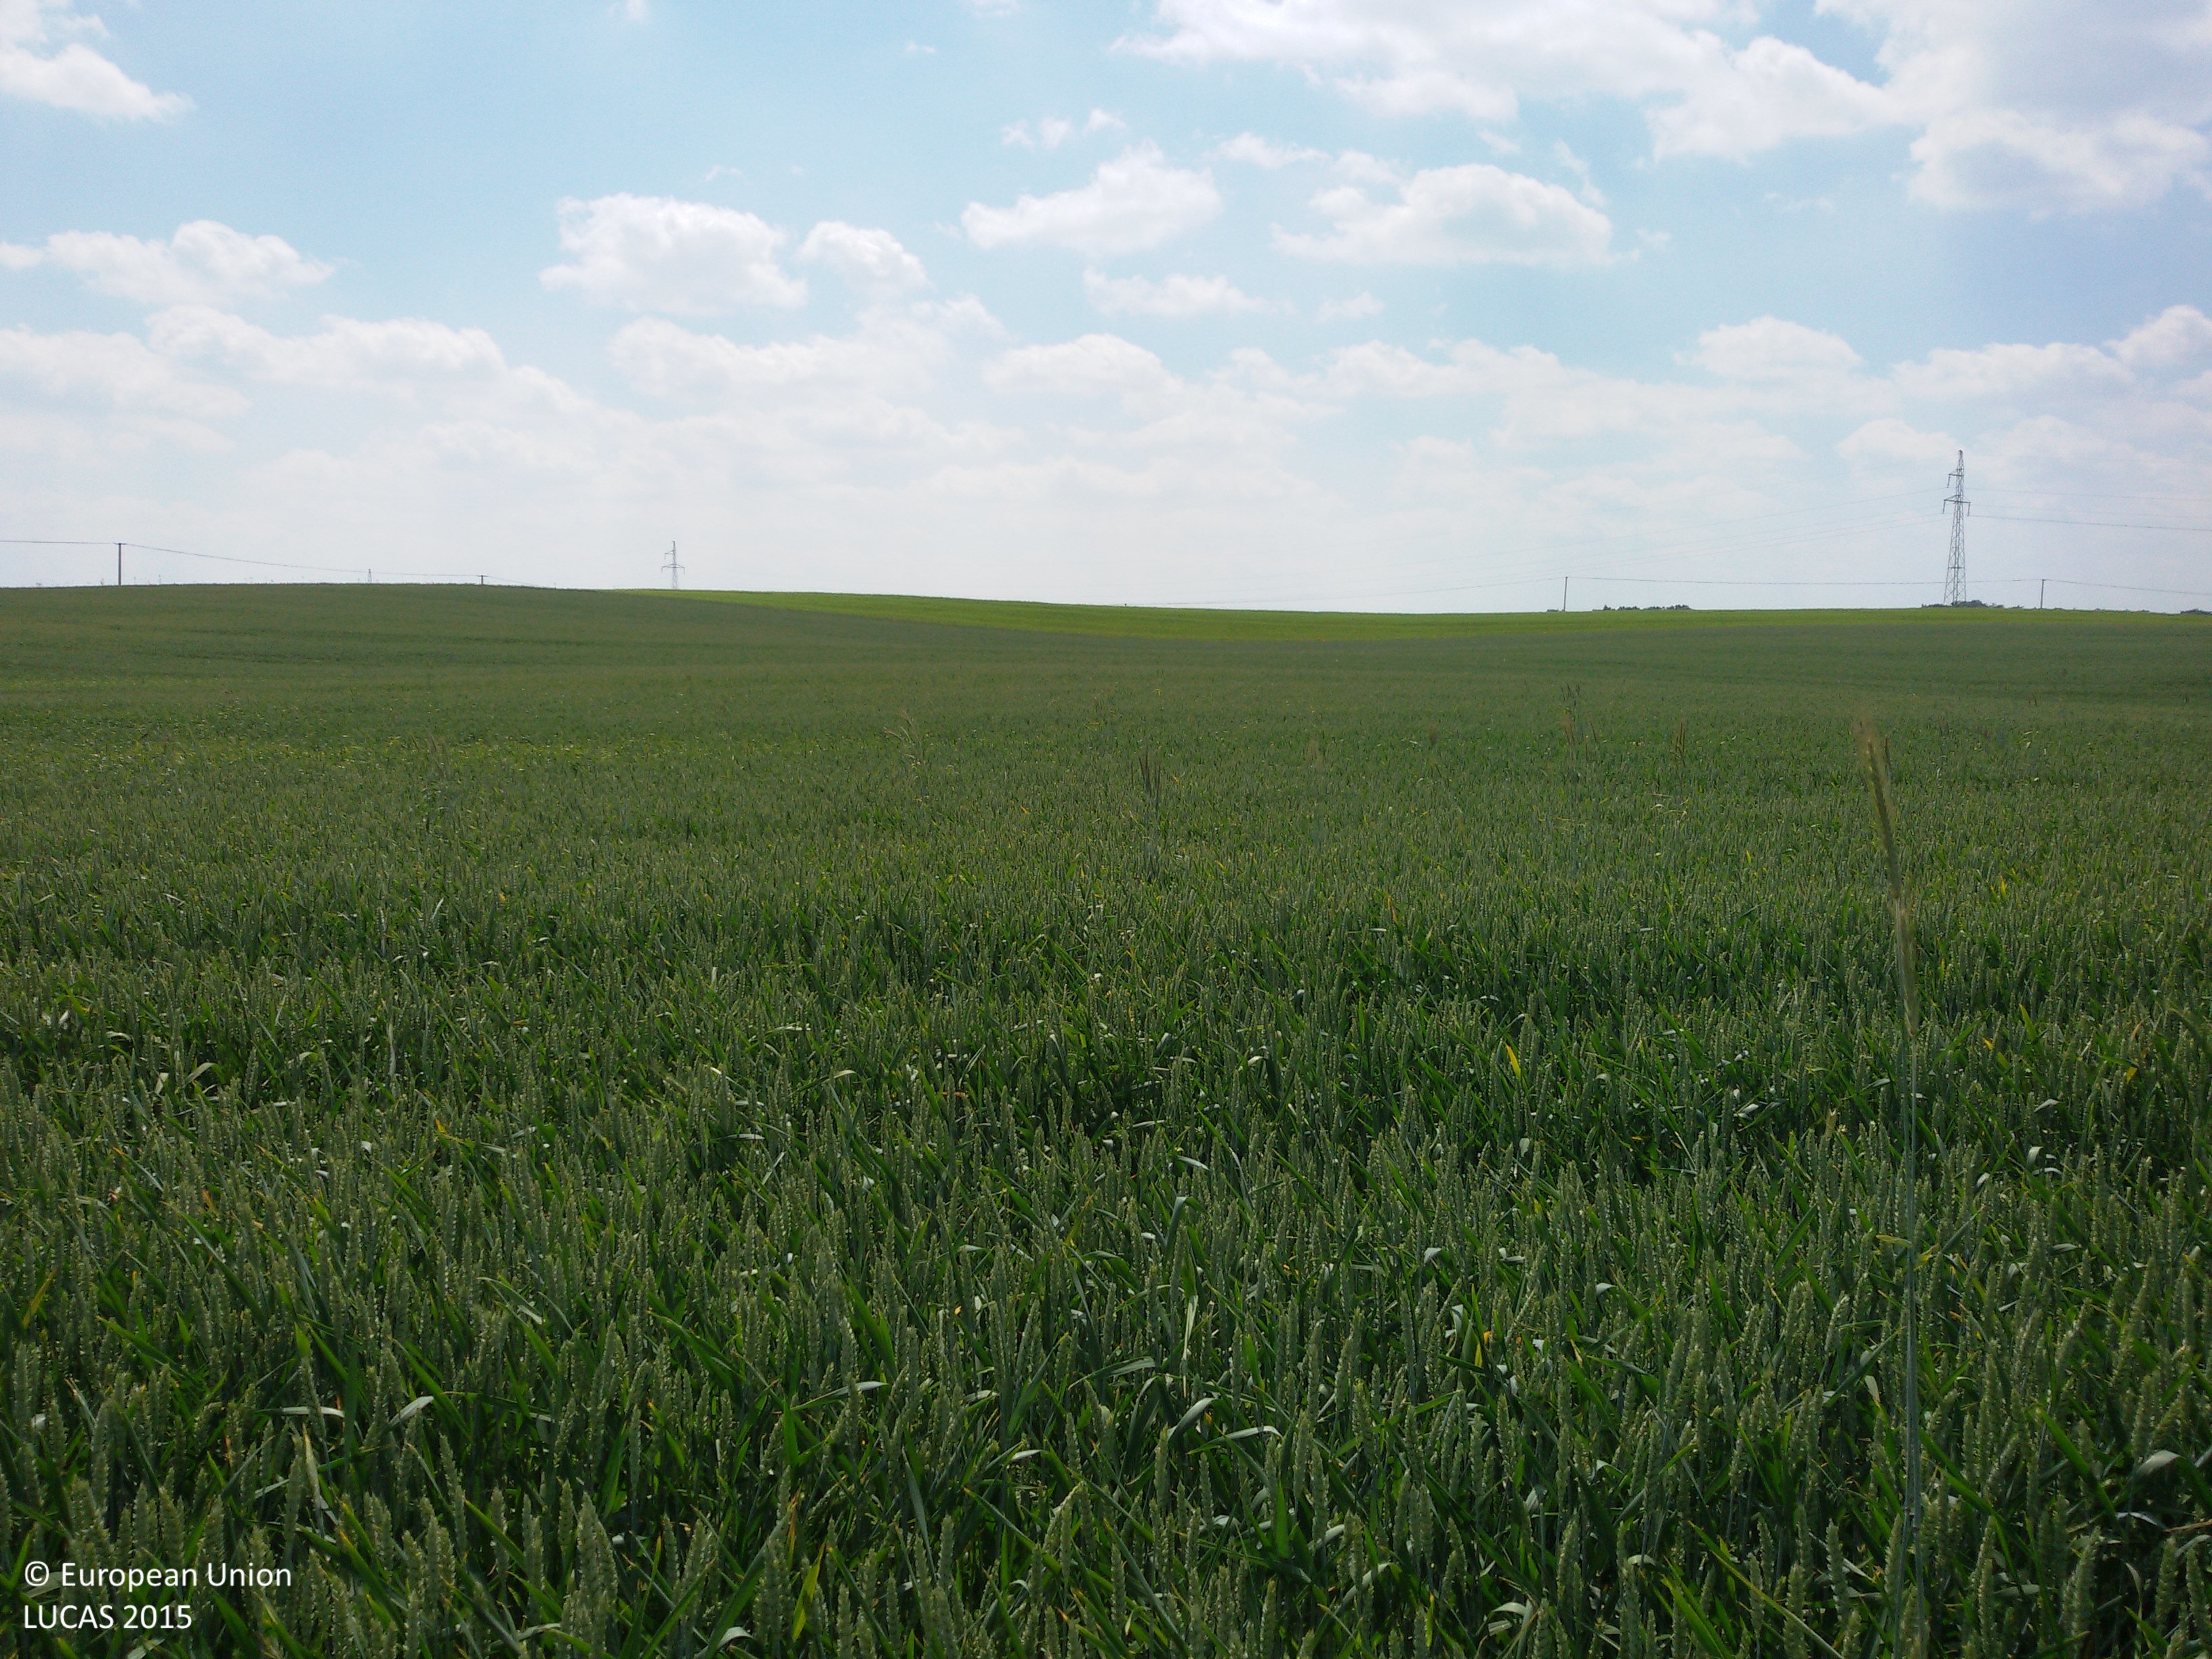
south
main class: Cropland
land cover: Common wheat
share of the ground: > 75 %
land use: Agriculture (excluding fallow land and kitchen gardens)
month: June
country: PL
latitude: 53.3935
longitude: 17.6670
